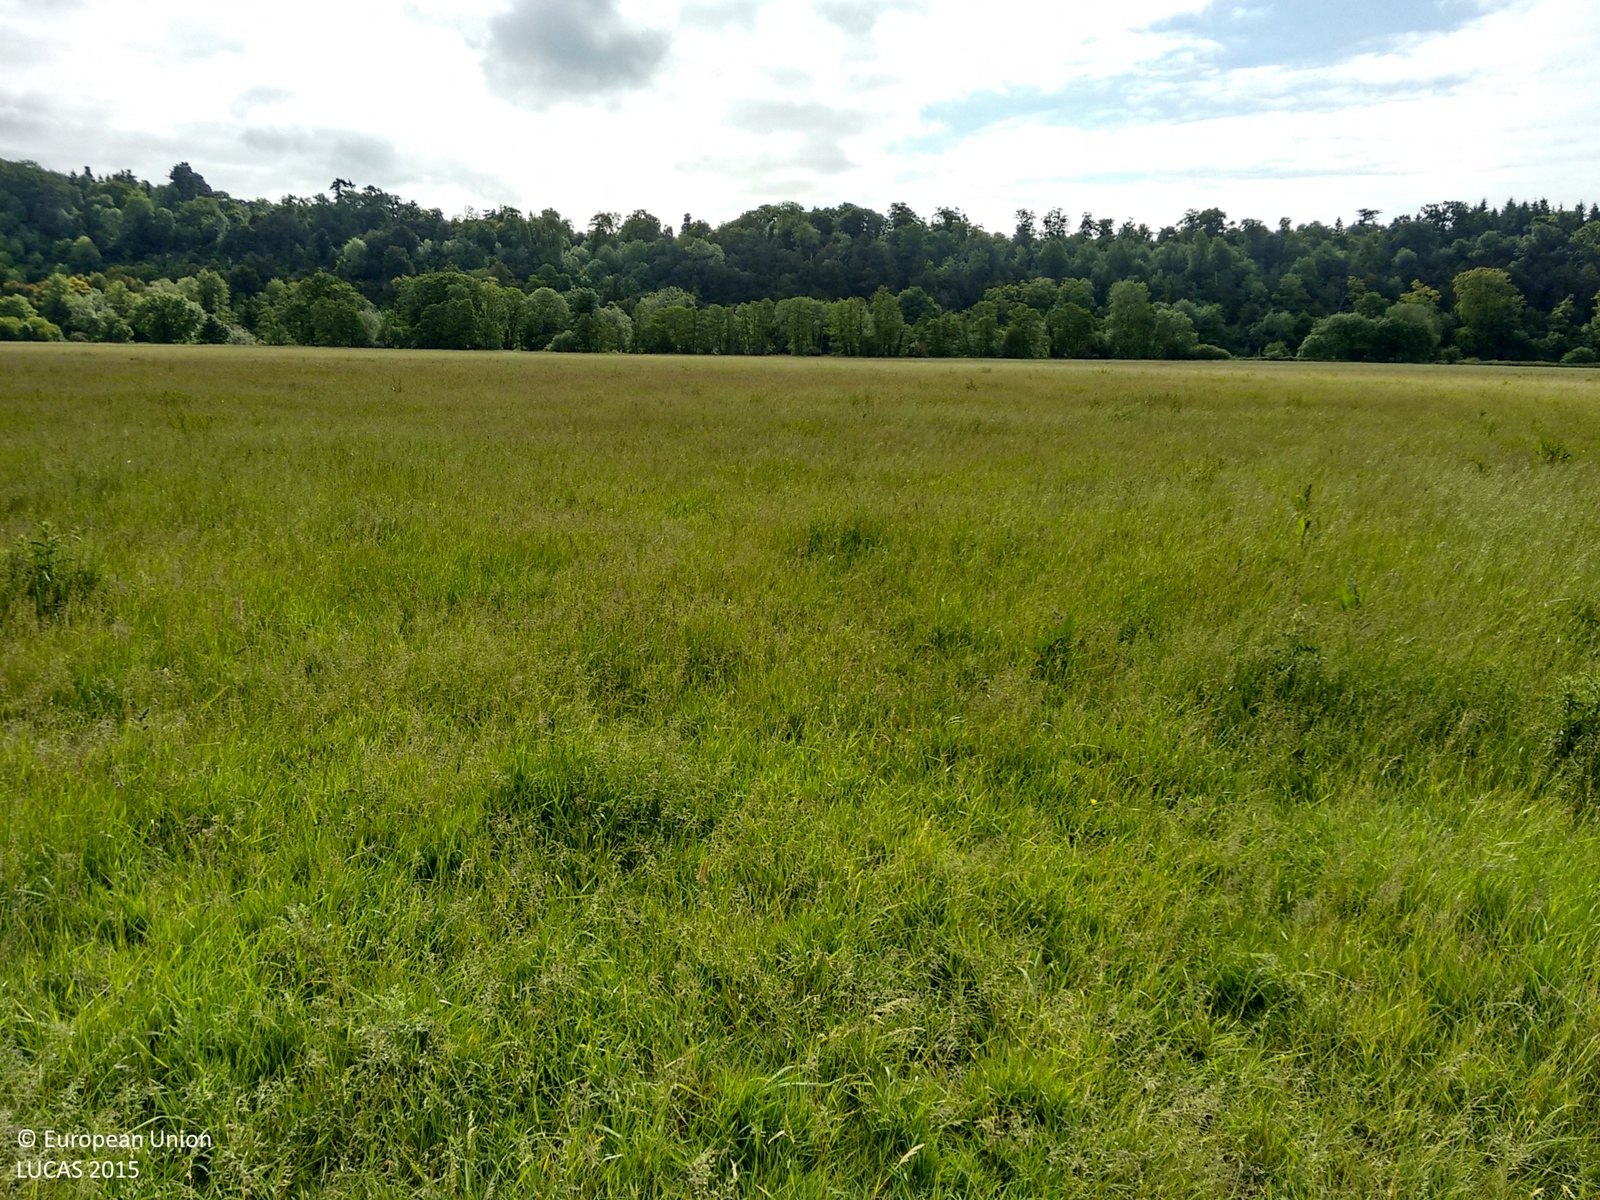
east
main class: Grassland
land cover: Grassland without tree/shrub cover
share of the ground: > 75 %
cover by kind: herbaceous plants 100 %
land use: Agriculture (excluding fallow land and kitchen gardens)
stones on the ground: < 10 %
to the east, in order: Grassland without tree/shrub cover
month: June
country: GB
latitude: 51.5479
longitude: -0.6976
